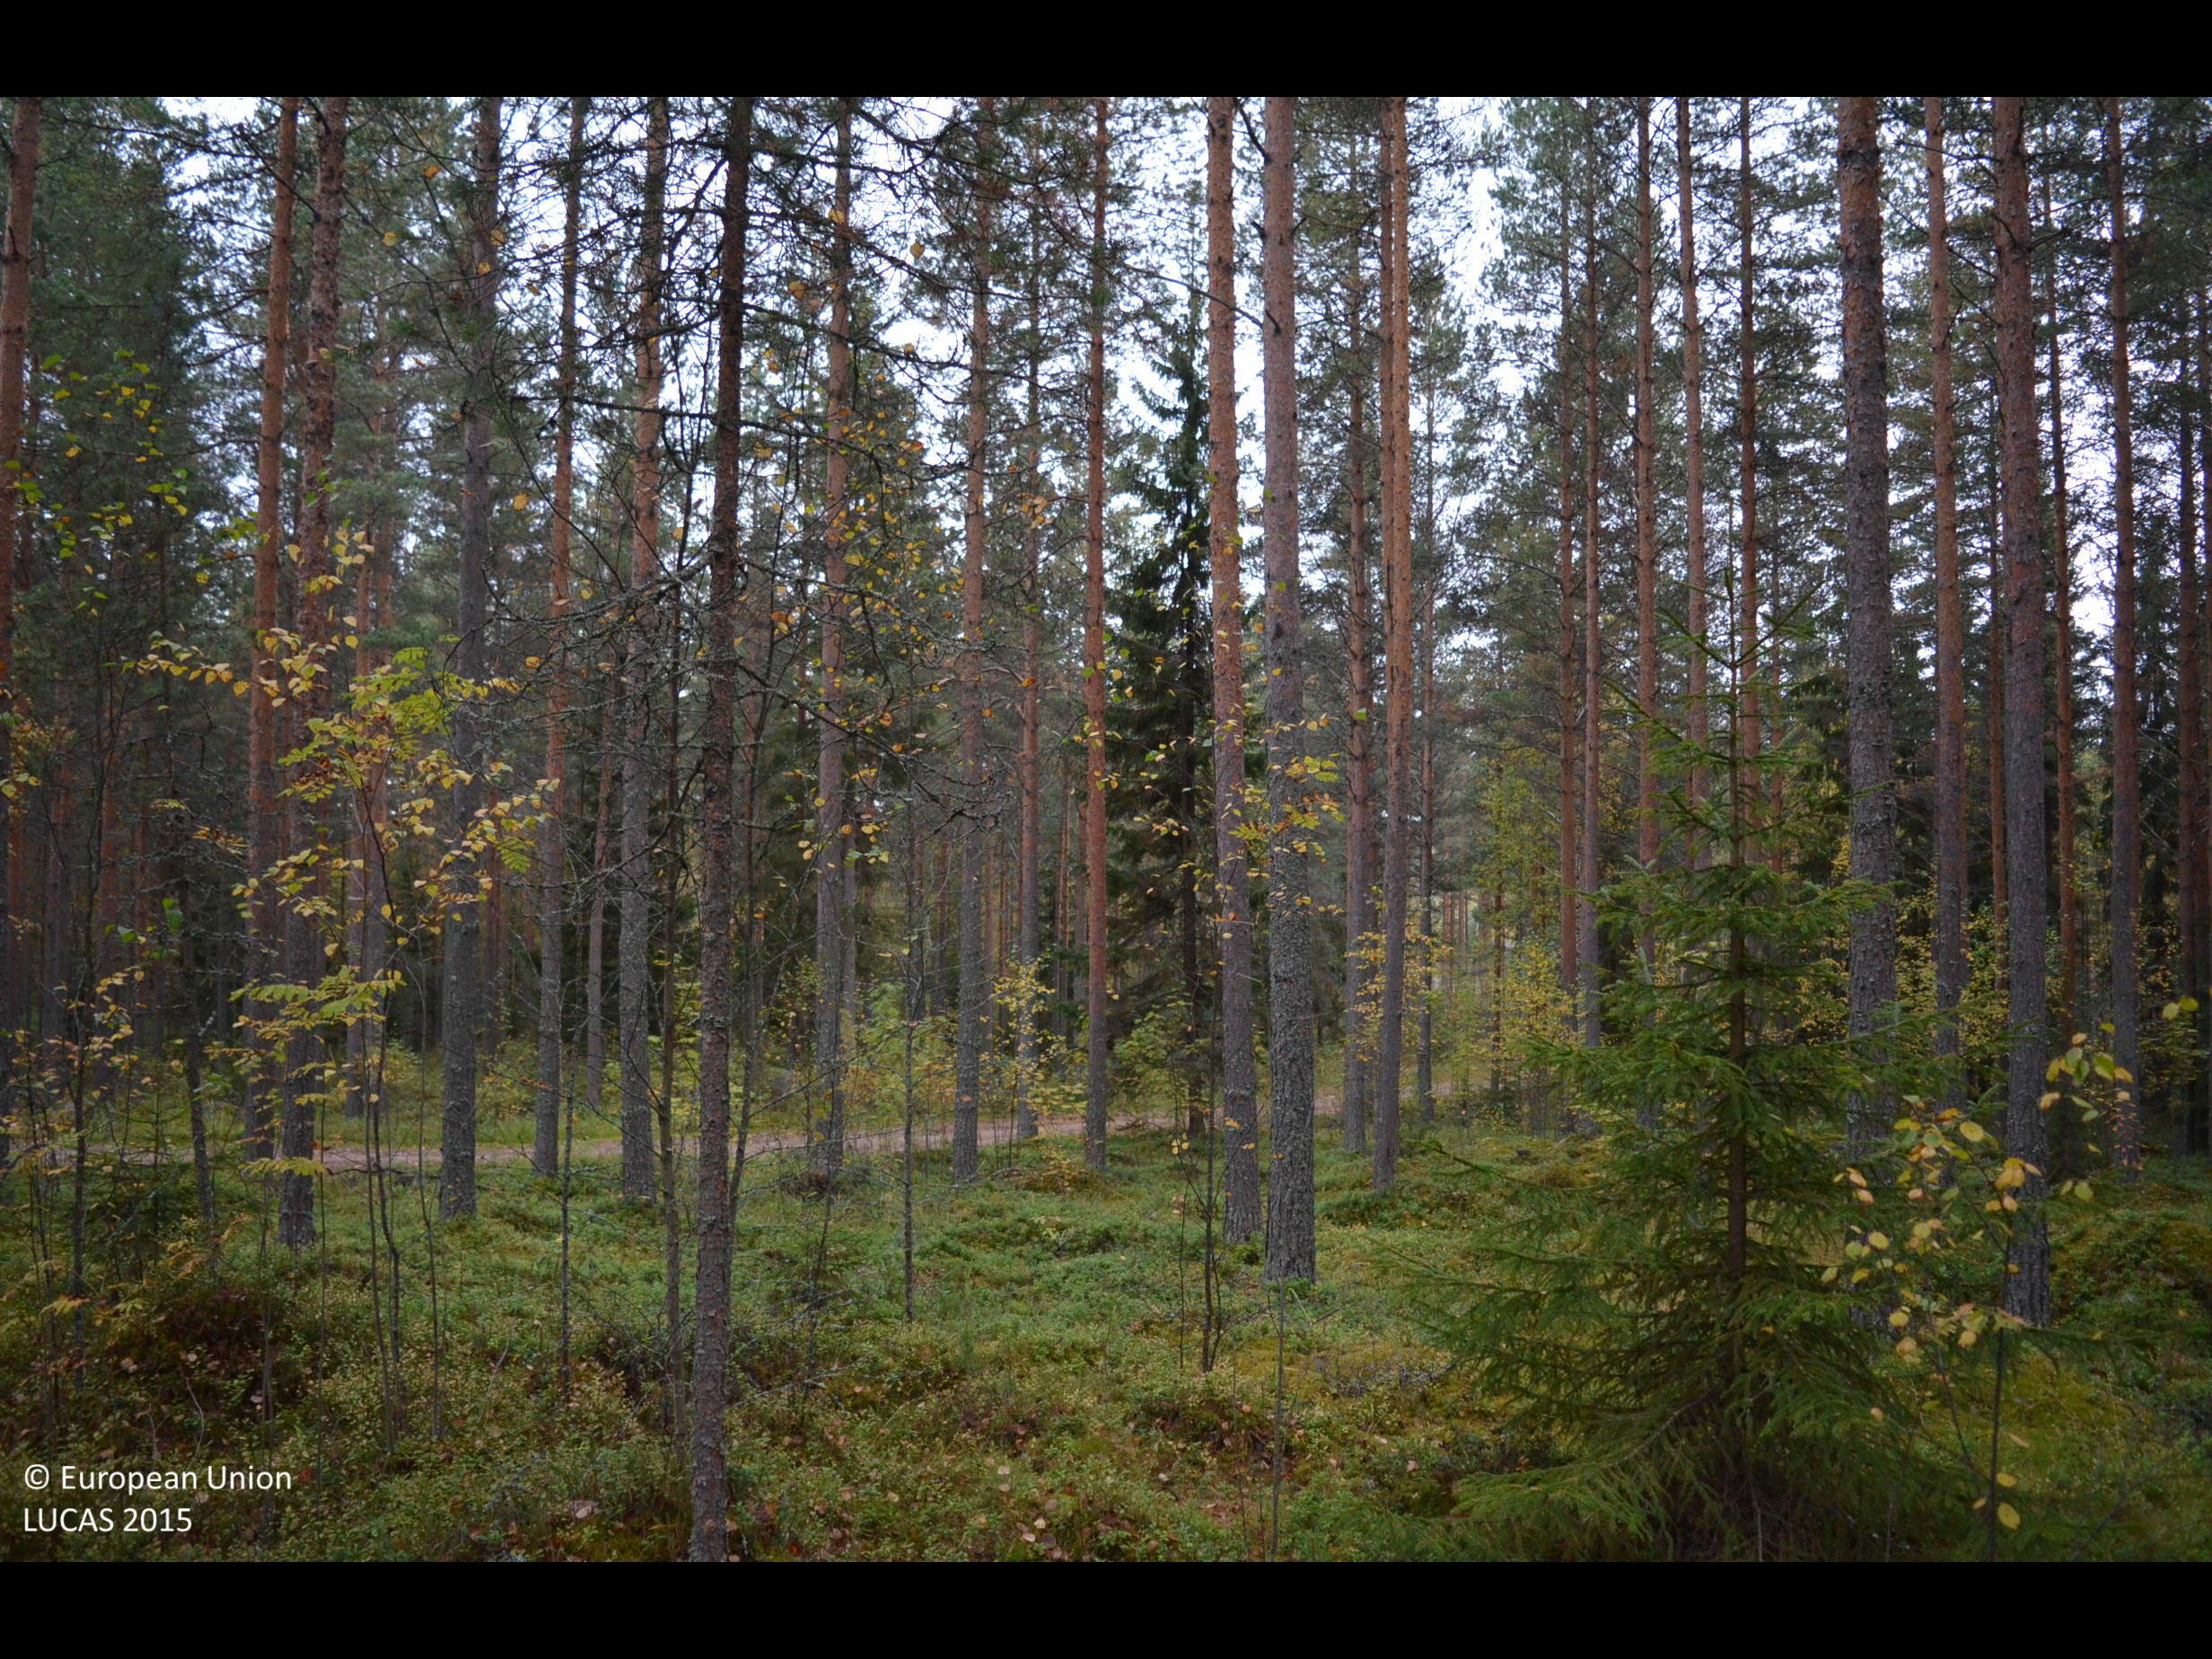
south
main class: Woodland
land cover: Pine dominated coniferous woodland
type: boreal forest
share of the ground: 50 - 75 %
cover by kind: coniferous forest trees 65 %, shrubs 25 %, broadleaved forest trees 5 %, lichens and mosses 5 %
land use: Forestry
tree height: > 5 m
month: September
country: FI
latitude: 62.5894
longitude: 23.6836
